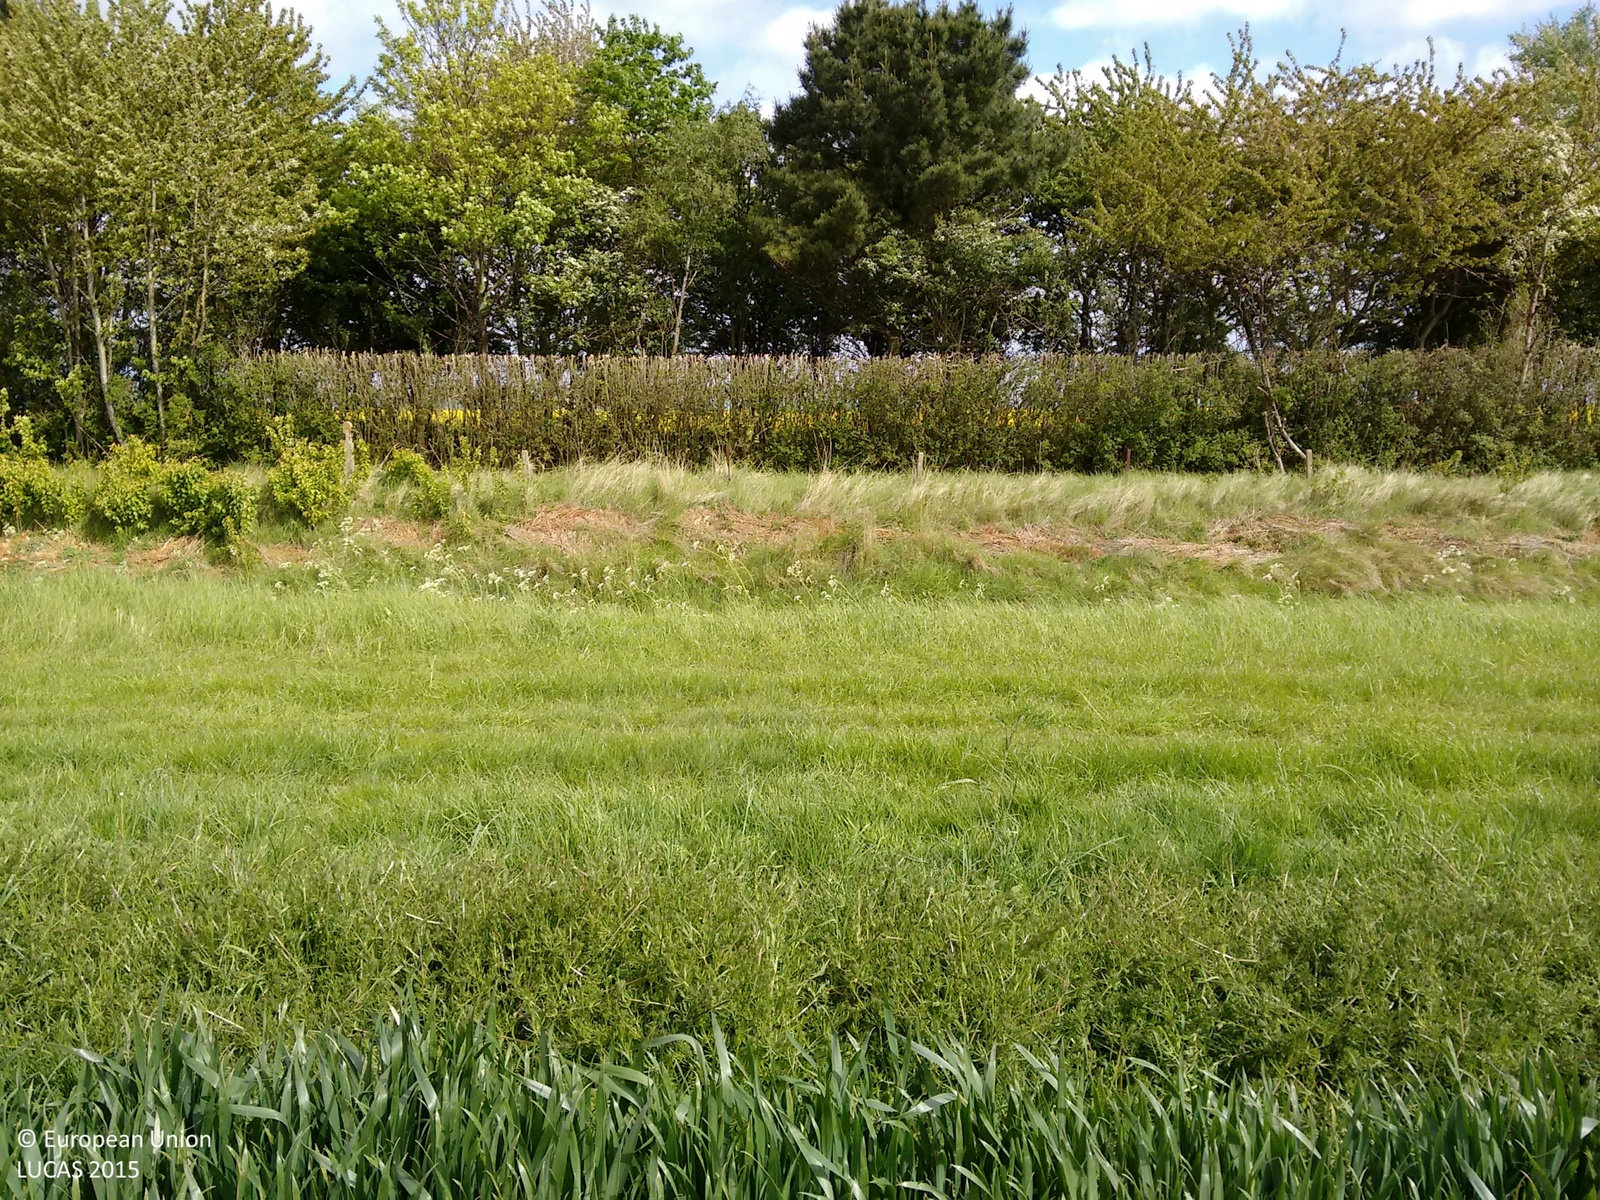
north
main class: Cropland
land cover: Common wheat
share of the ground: > 75 %
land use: Agriculture (excluding fallow land and kitchen gardens)
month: May
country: GB
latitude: 52.8063
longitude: 0.2239
